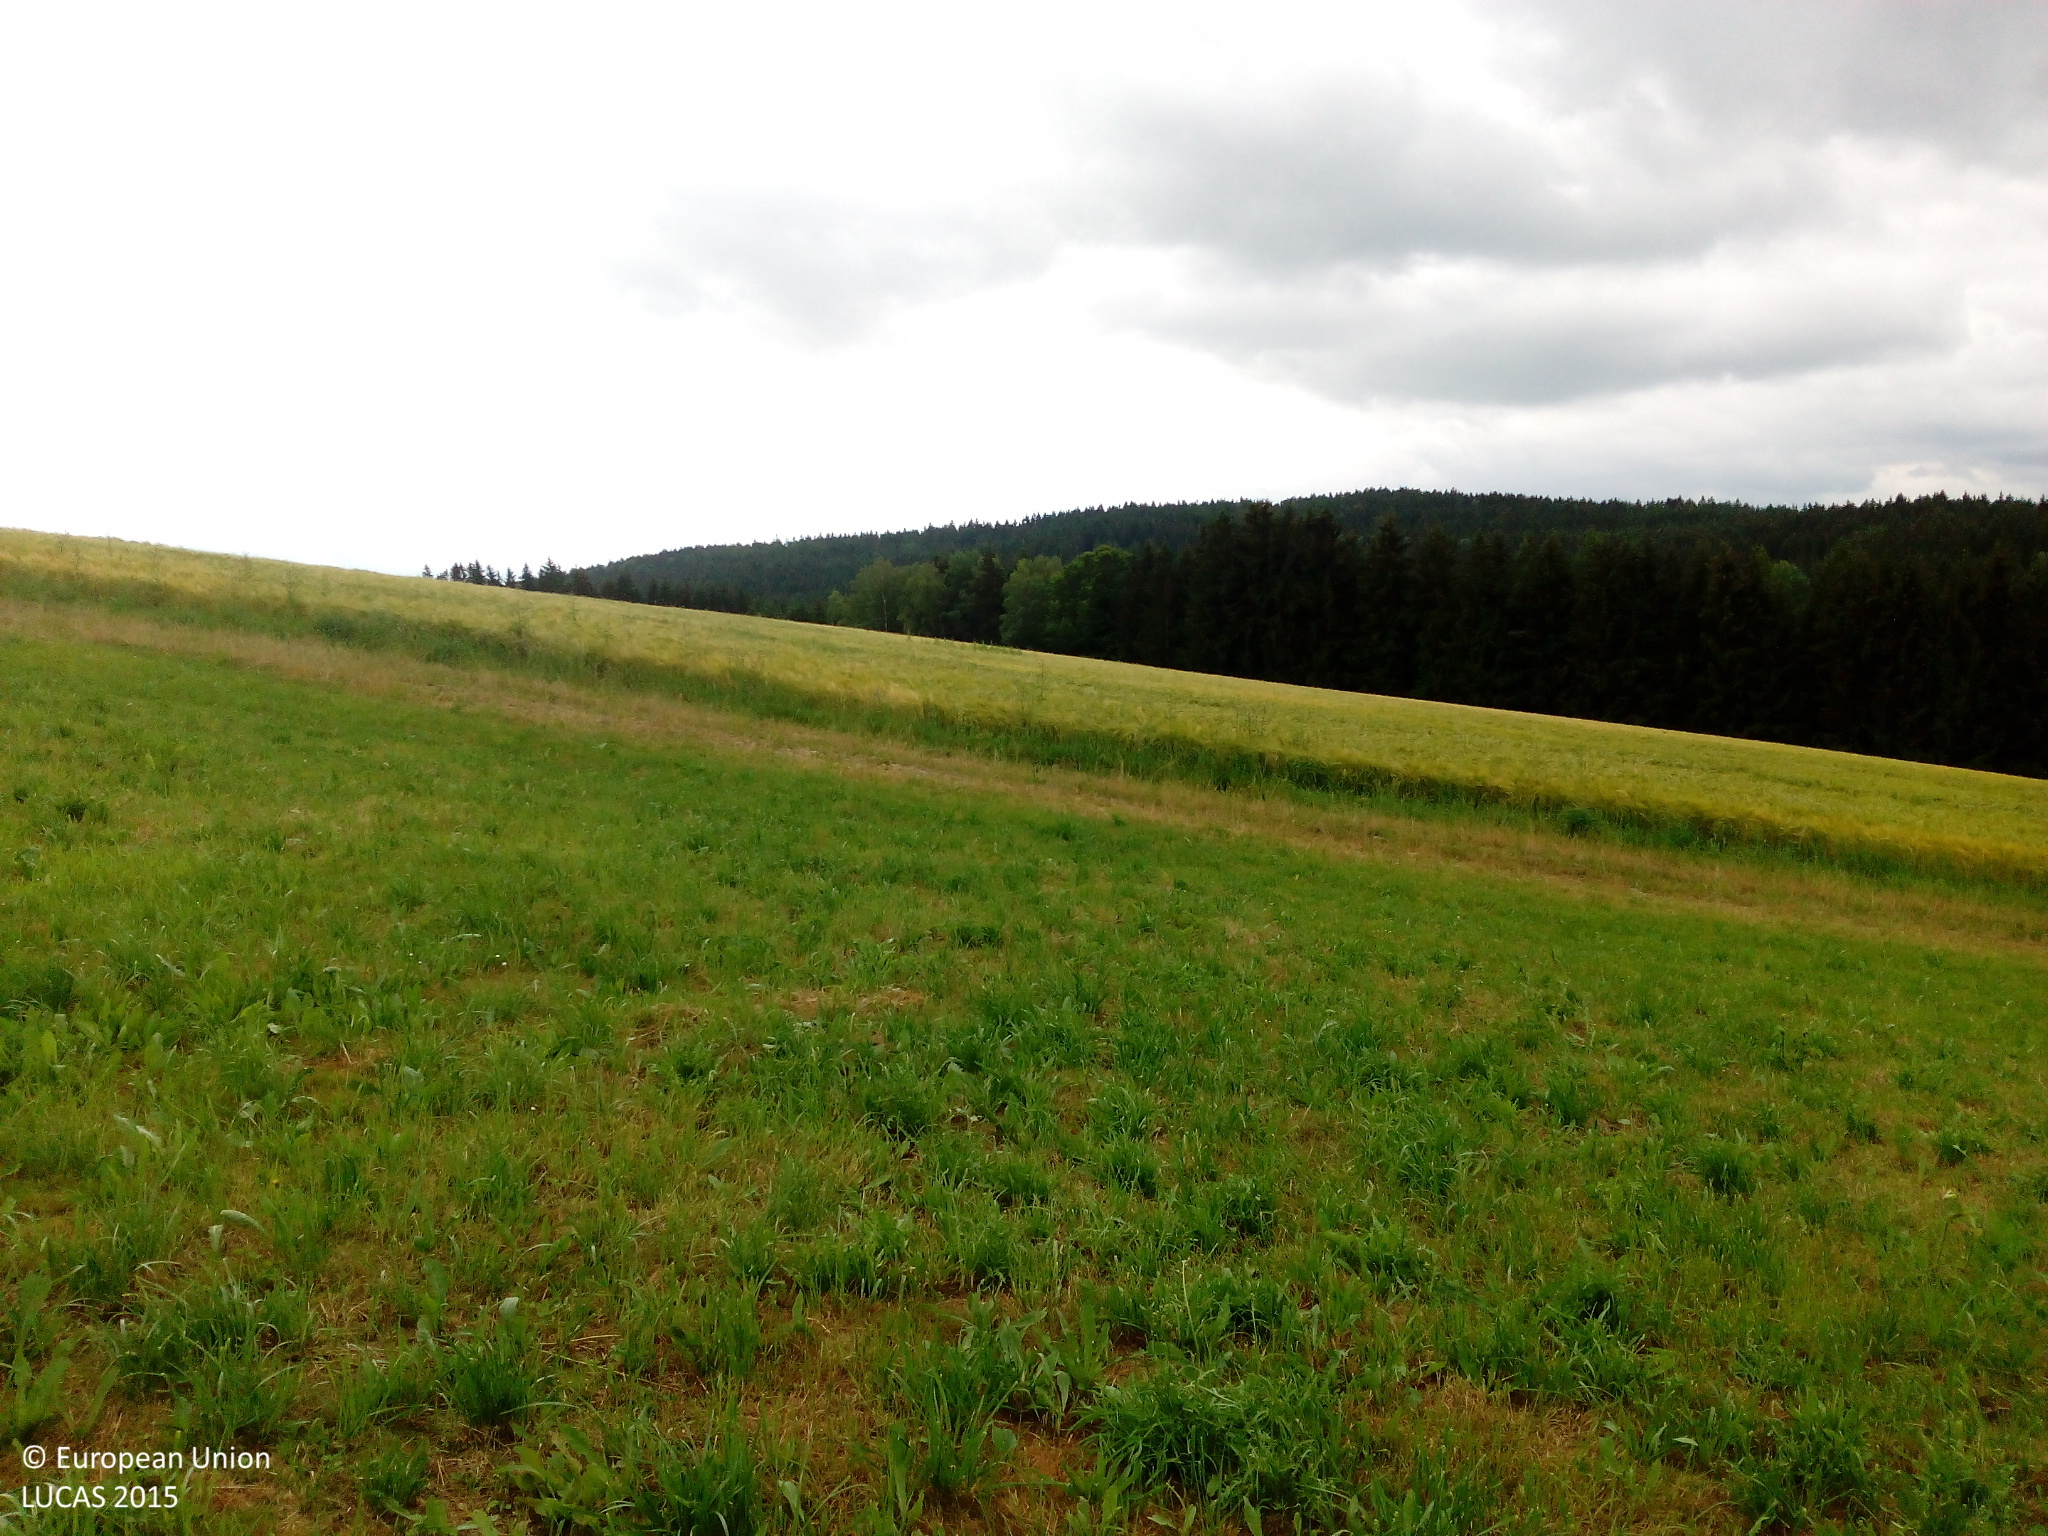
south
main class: Grassland
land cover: Grassland without tree/shrub cover
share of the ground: > 75 %
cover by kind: herbaceous plants 75 %, unconsolidated bare surface 5 %
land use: Agriculture (excluding fallow land and kitchen gardens)
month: July
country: DE
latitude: 49.4924
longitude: 12.4432
